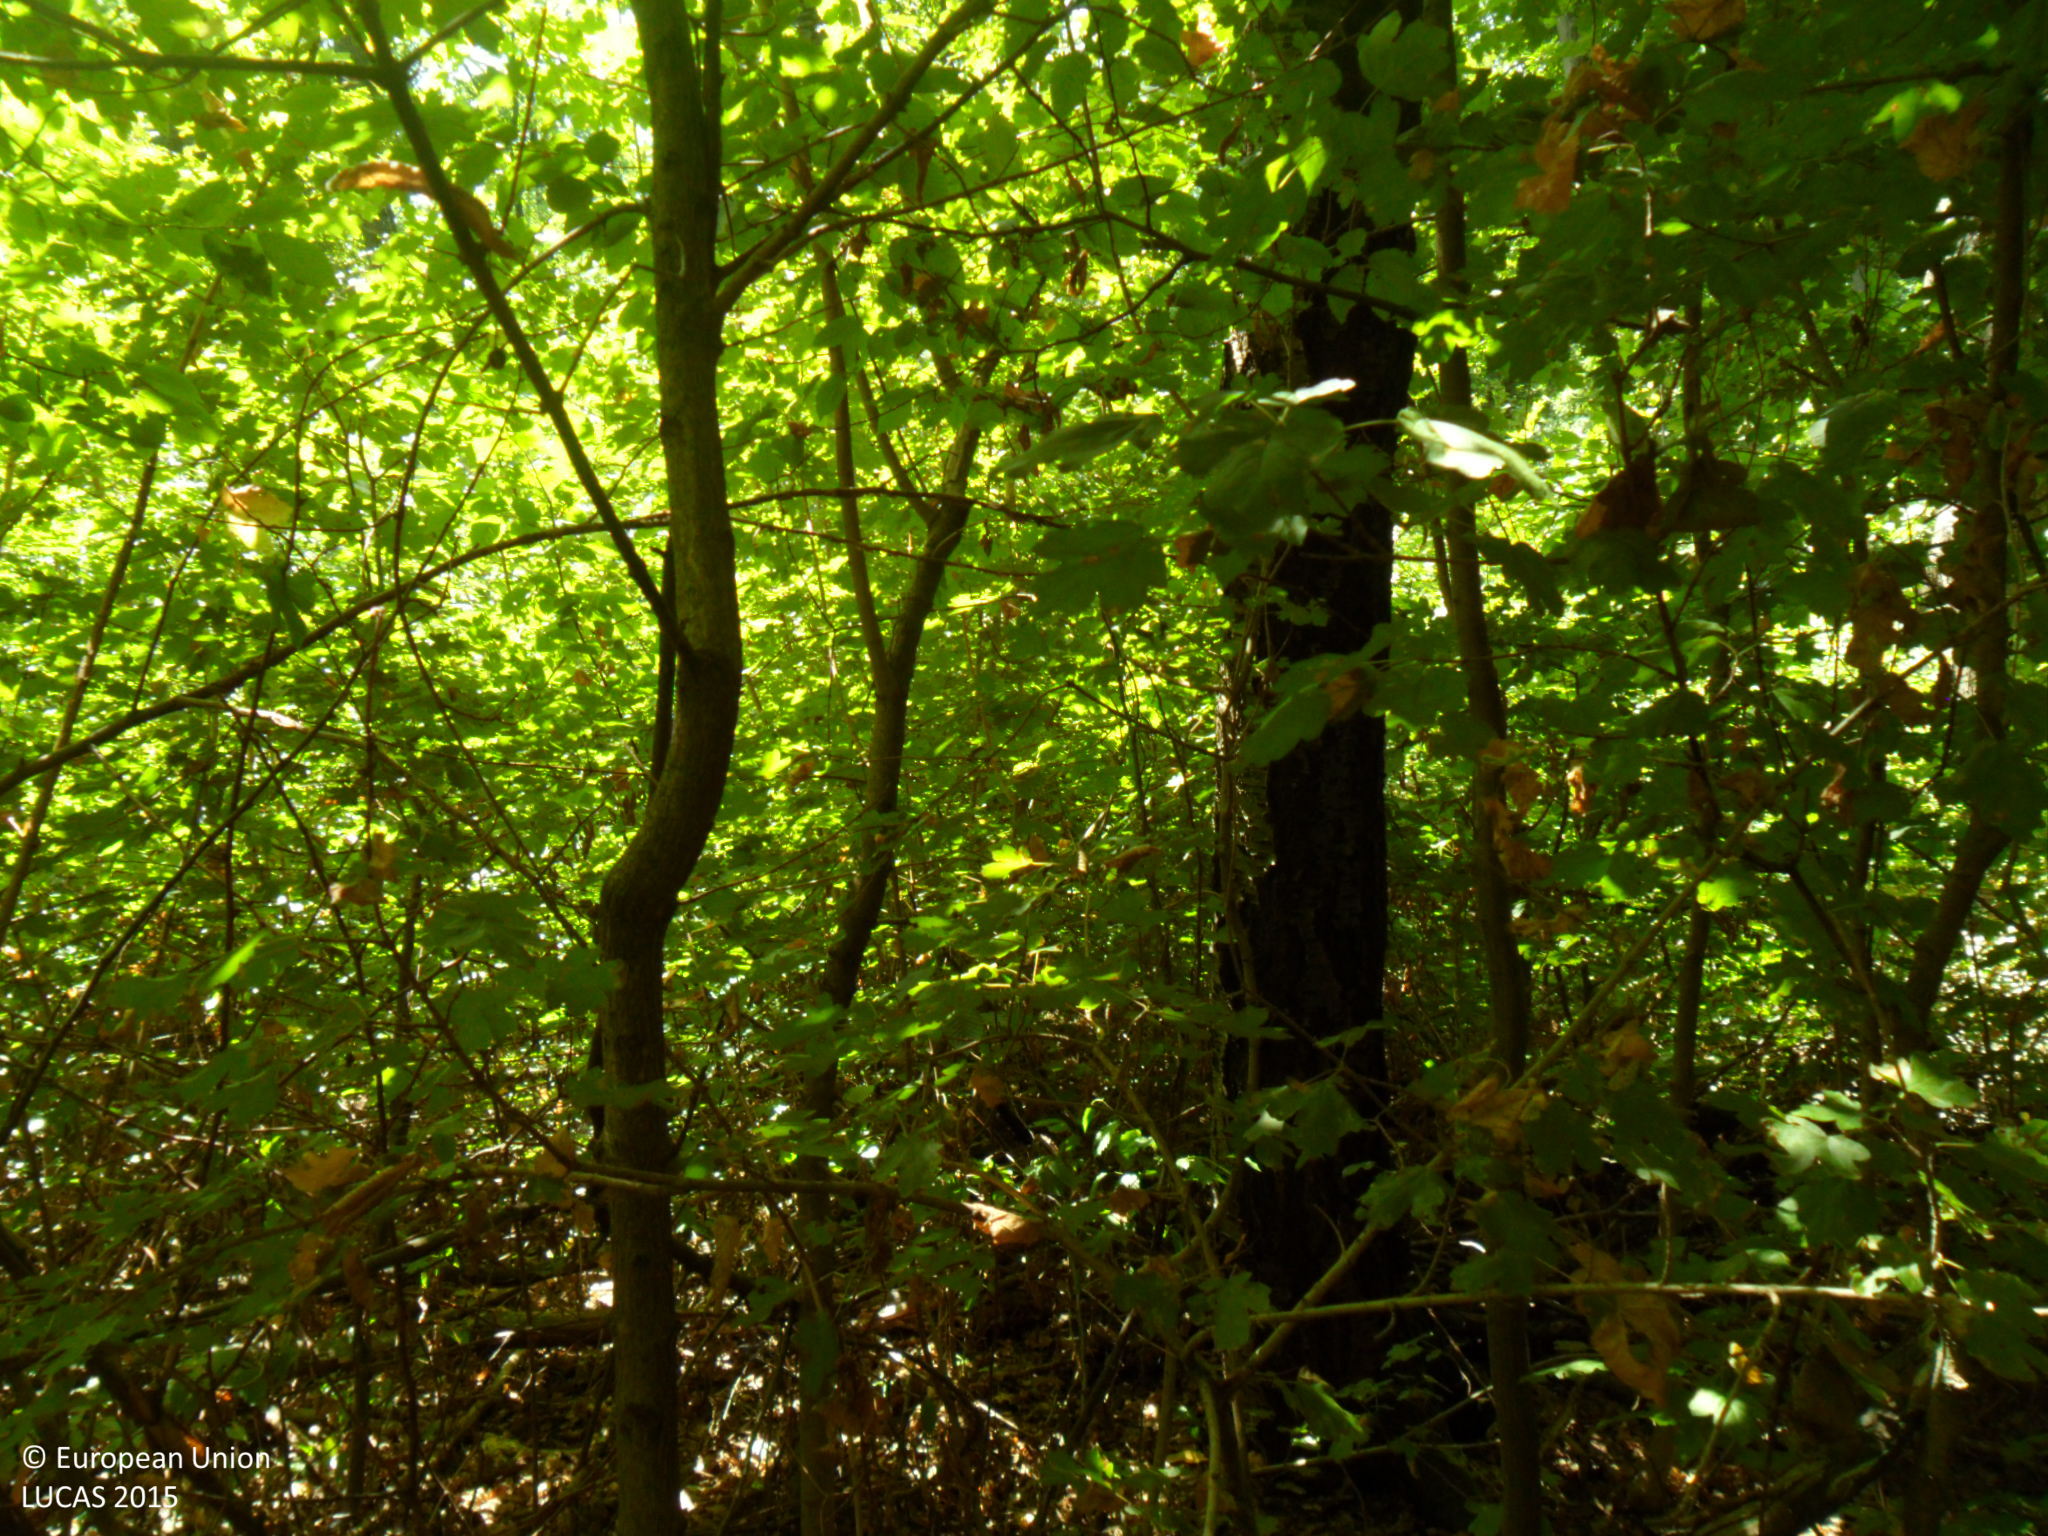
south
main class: Woodland
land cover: Broadleaved woodland
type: mesophytic deciduous forest
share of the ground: > 75 %
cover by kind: broadleaved forest trees 100 %
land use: Forestry
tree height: > 5 m
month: August
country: BG
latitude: 43.5580
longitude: 26.6859
